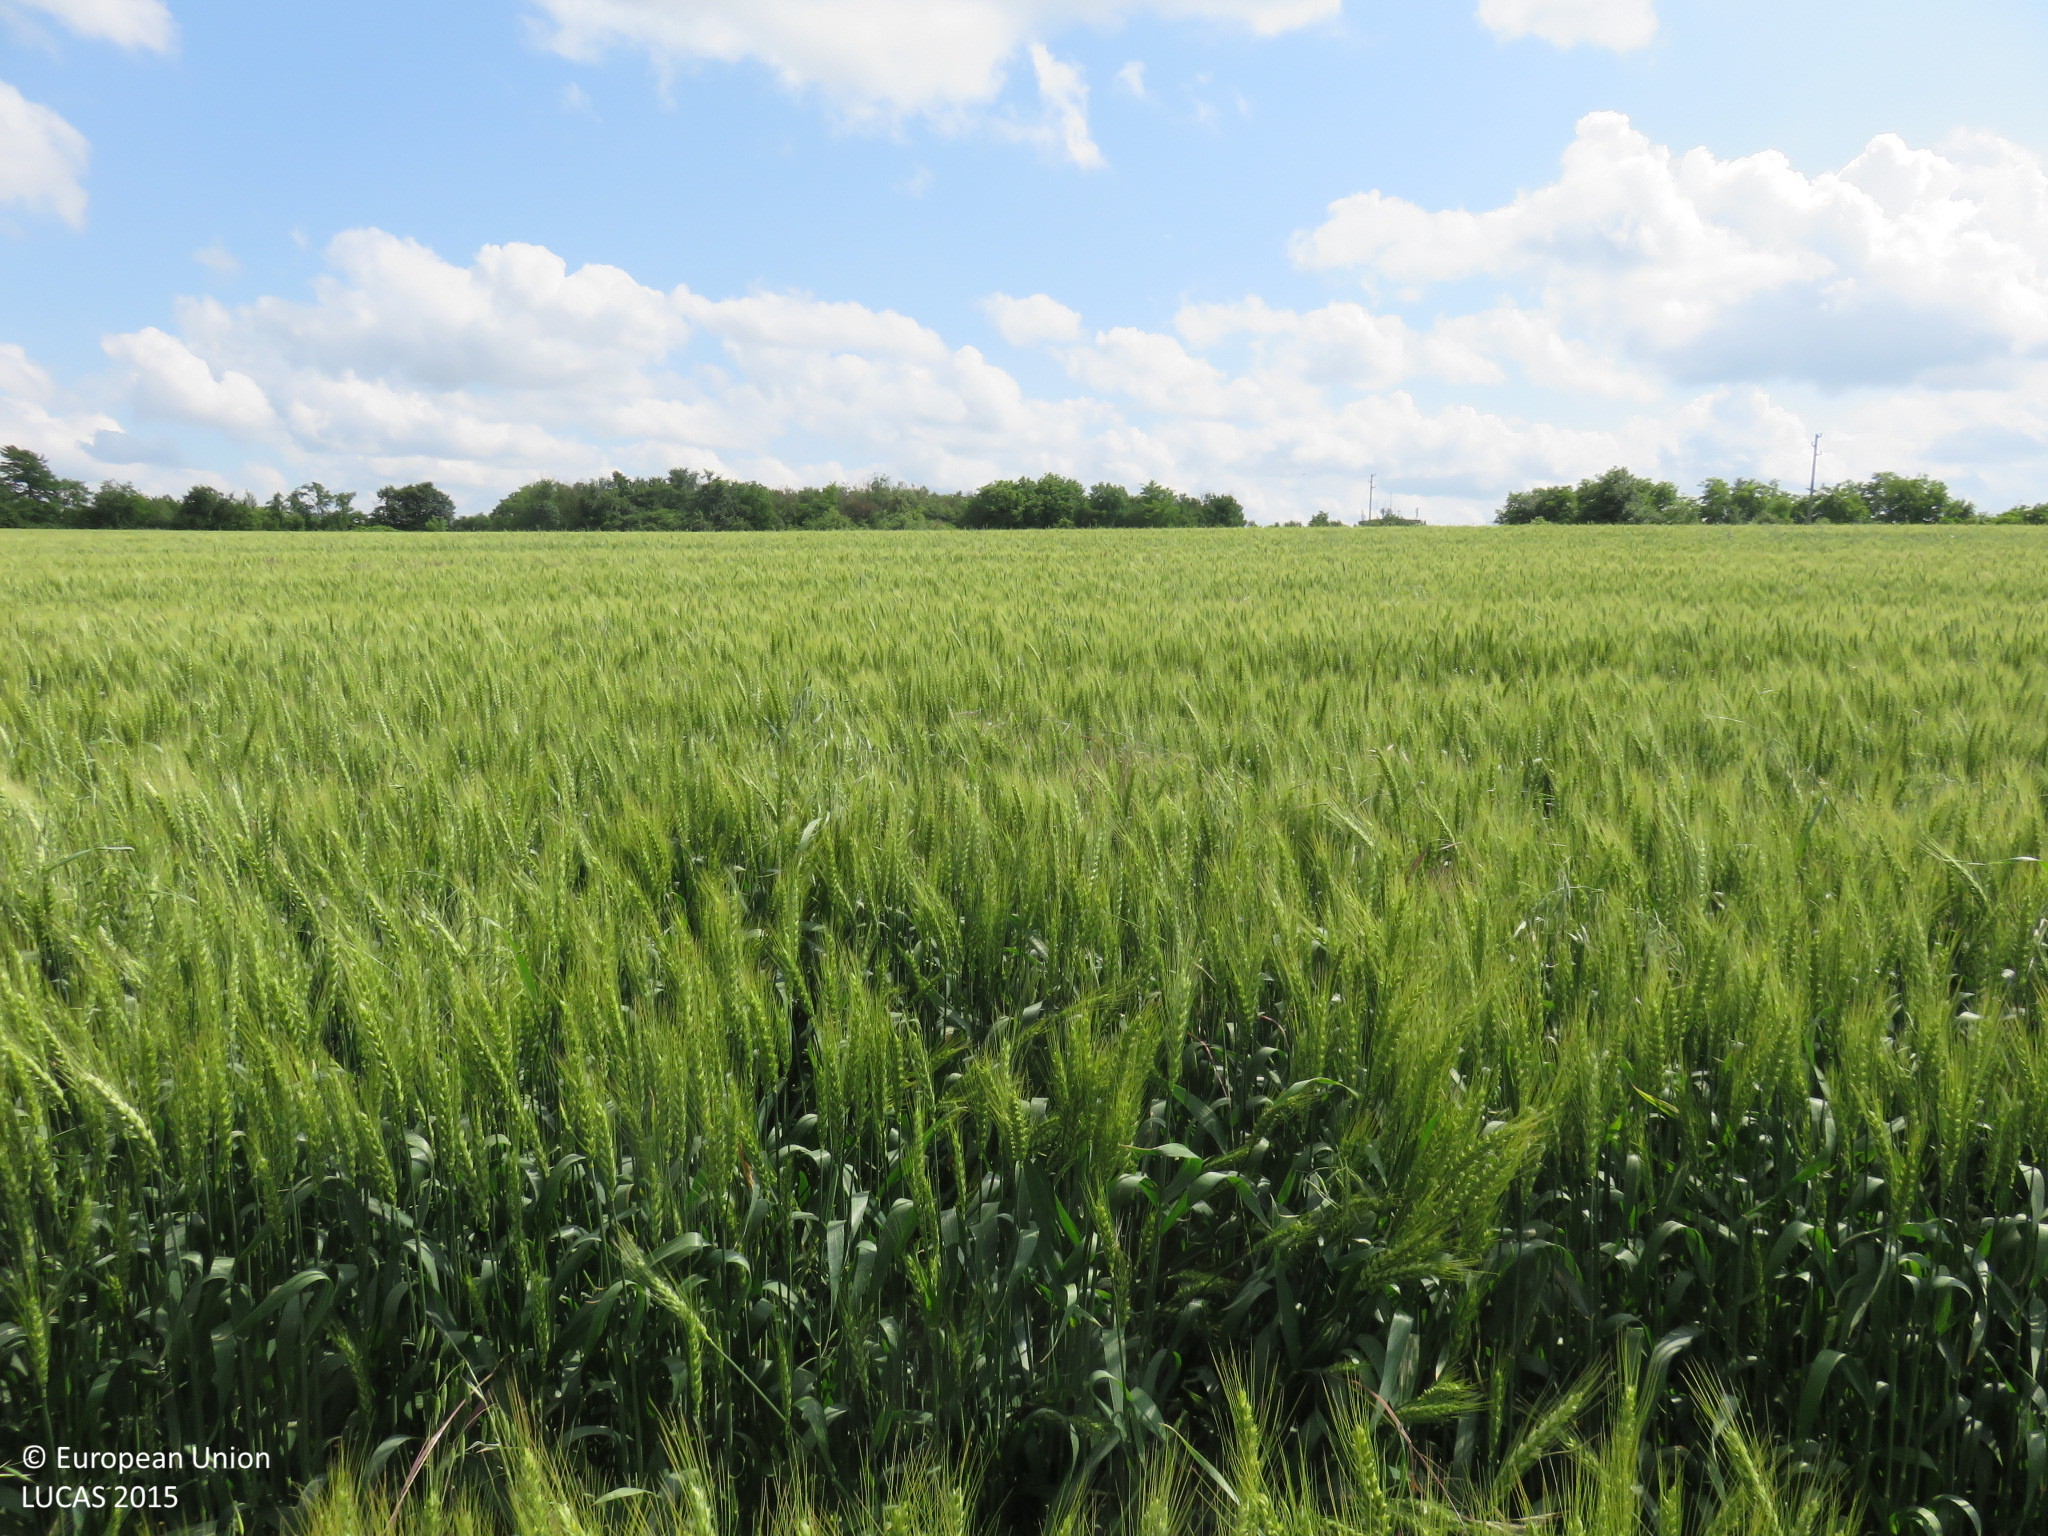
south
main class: Cropland
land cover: Common wheat
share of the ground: > 75 %
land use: Agriculture (excluding fallow land and kitchen gardens)
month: May
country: BG
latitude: 43.3859
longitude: 24.5913
